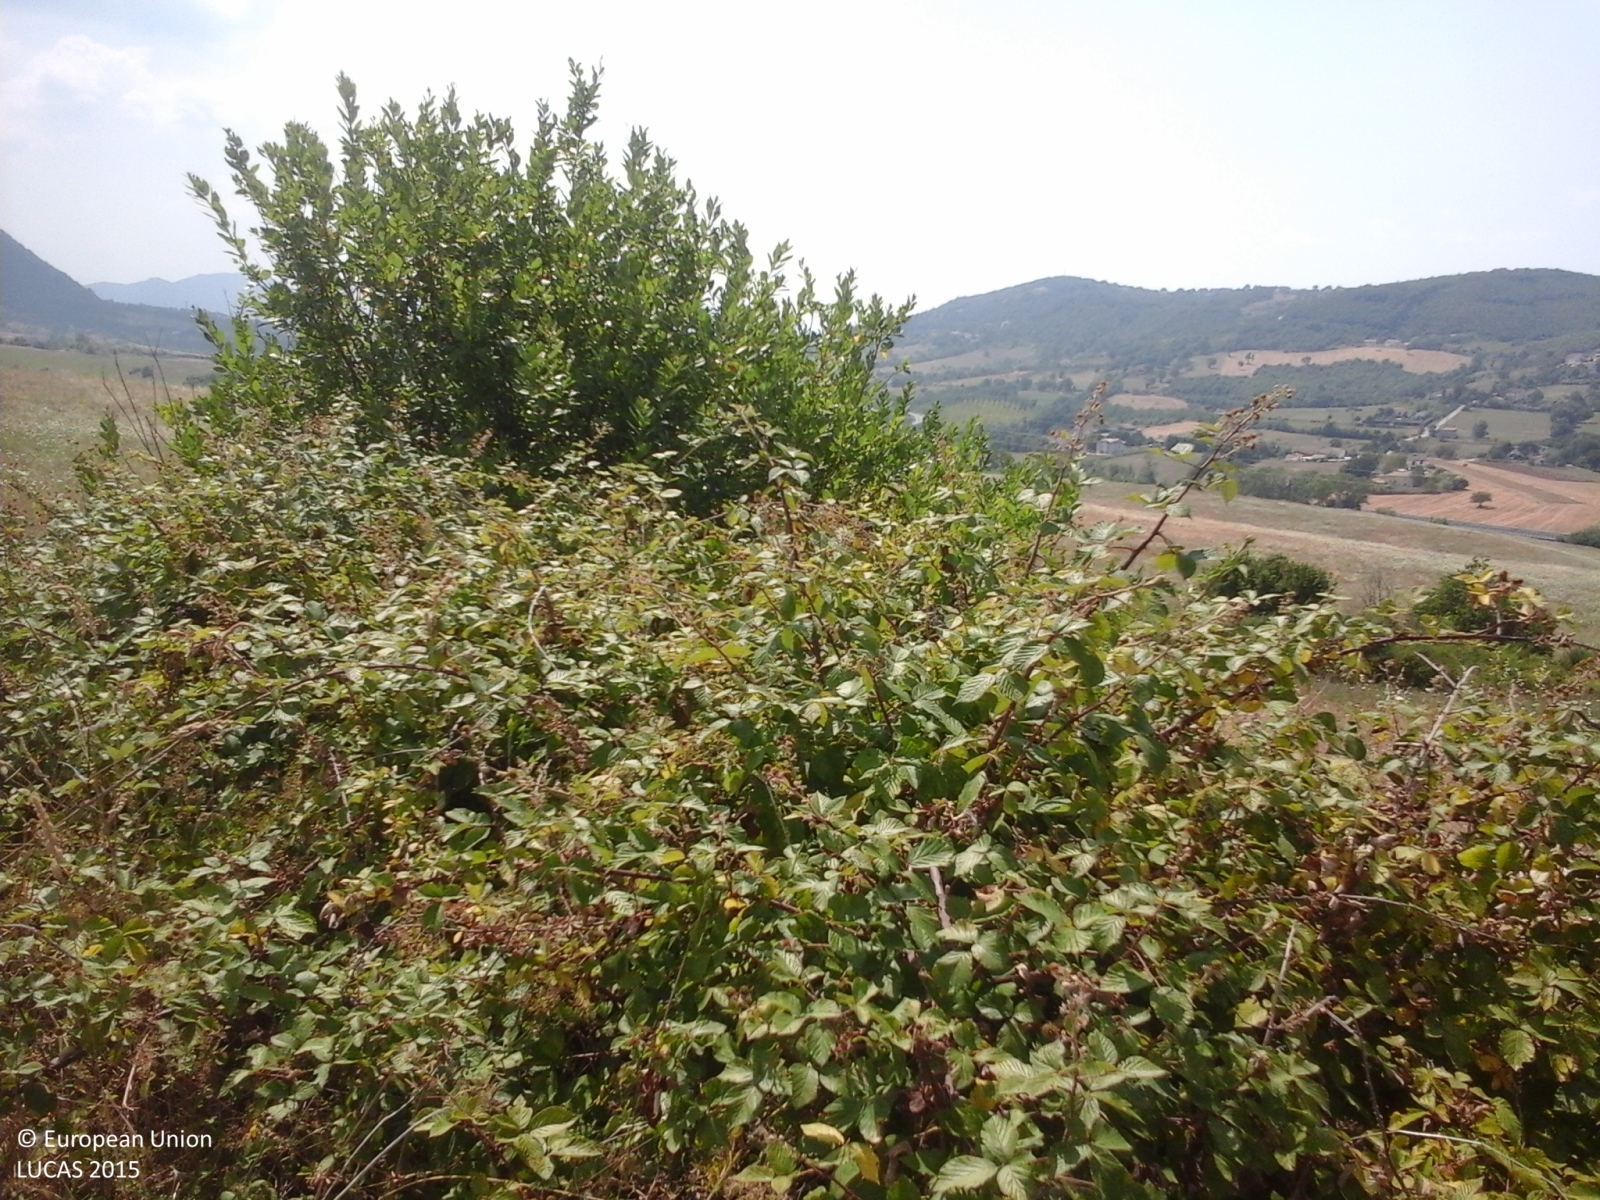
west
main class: Cropland
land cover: Lucerne
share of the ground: > 75 %
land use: Agriculture (excluding fallow land and kitchen gardens)
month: July
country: IT
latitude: 40.8757
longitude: 15.1418
